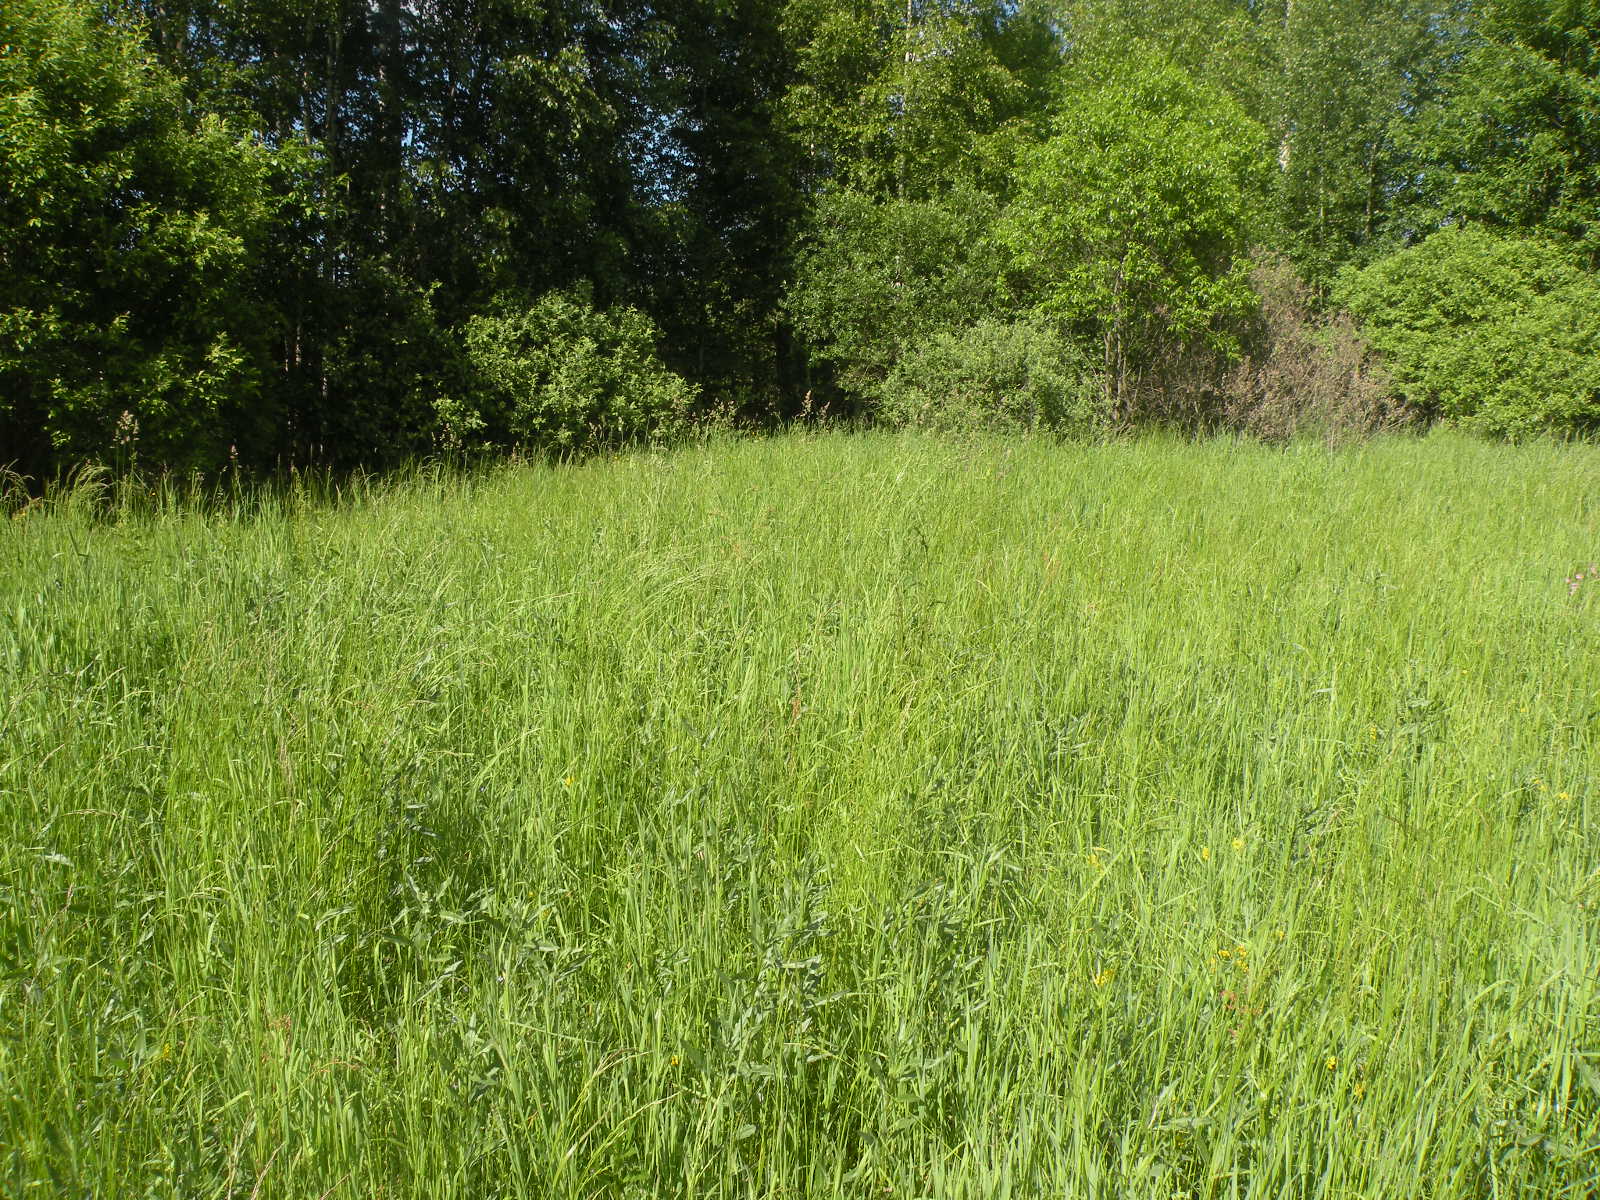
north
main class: Grassland
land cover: Grassland without tree/shrub cover
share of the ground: > 75 %
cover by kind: herbaceous plants 100 %
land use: Agriculture (excluding fallow land and kitchen gardens)
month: June
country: LV
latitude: 55.9297
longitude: 26.6900
